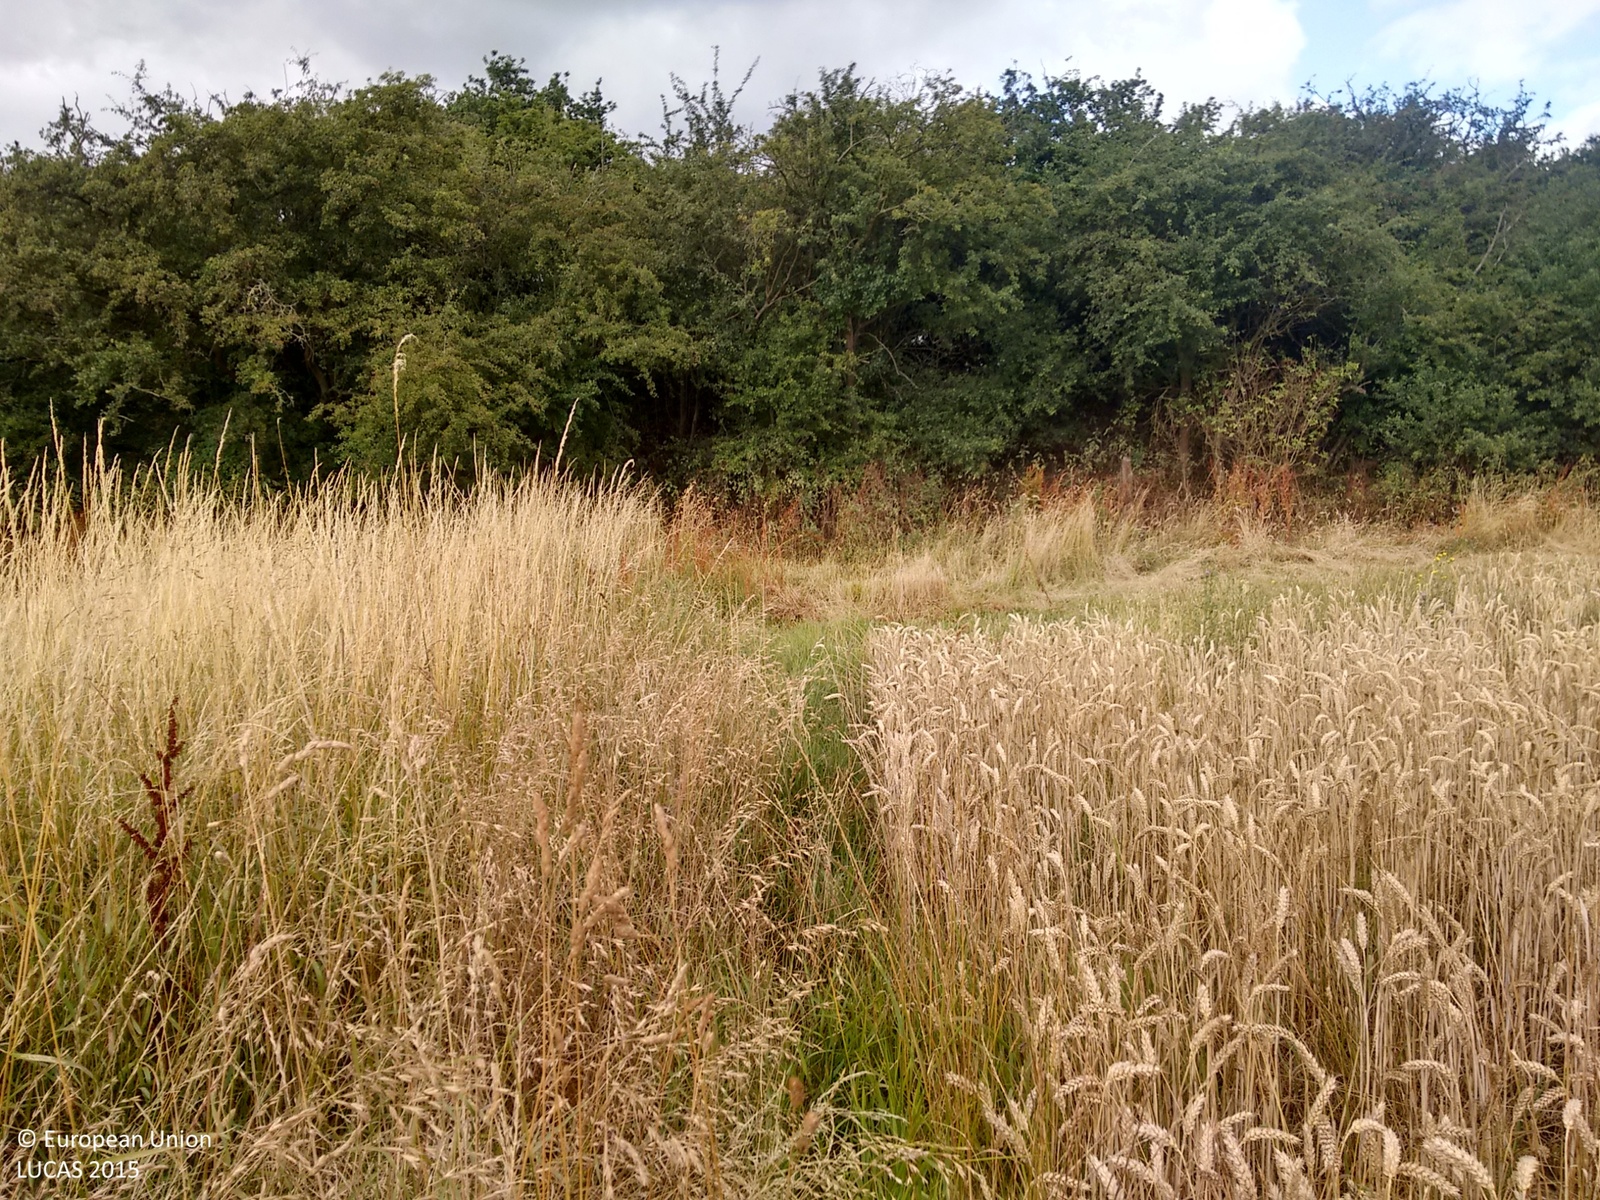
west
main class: Cropland
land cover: Common wheat
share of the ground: > 75 %
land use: Agriculture (excluding fallow land and kitchen gardens)
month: July
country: GB
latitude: 51.6838
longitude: 0.6735
